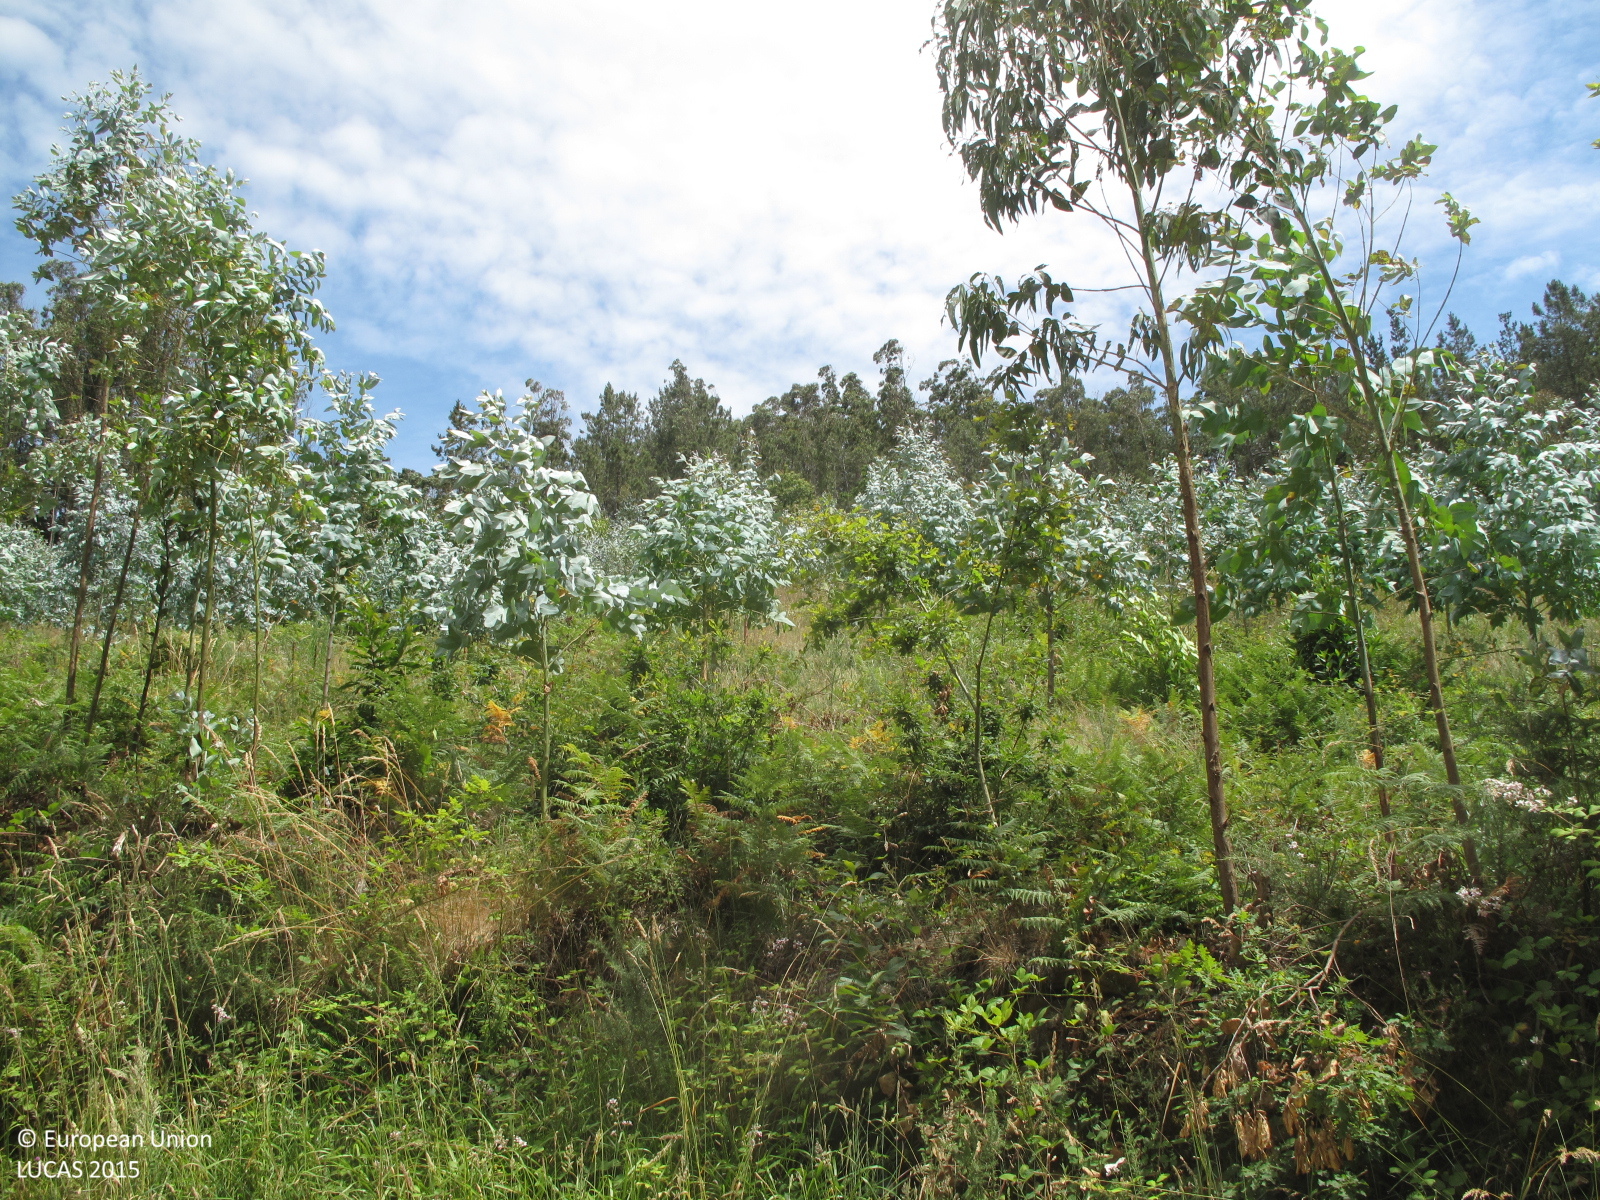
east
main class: Woodland
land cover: Pine dominated mixed woodland
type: coniferous forest of the mediterranean region
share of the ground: > 75 %
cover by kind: coniferous forest trees 50 %, broadleaved forest trees 30 %, shrubs 20 %
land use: Forestry
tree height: > 5 m
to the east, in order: Pine dominated mixed woodland; Tracks; Broadleaved woodland; Tracks; Broadleaved woodland; Grassland without tree/shrub cover
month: July
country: ES
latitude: 43.1637
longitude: -8.6217
